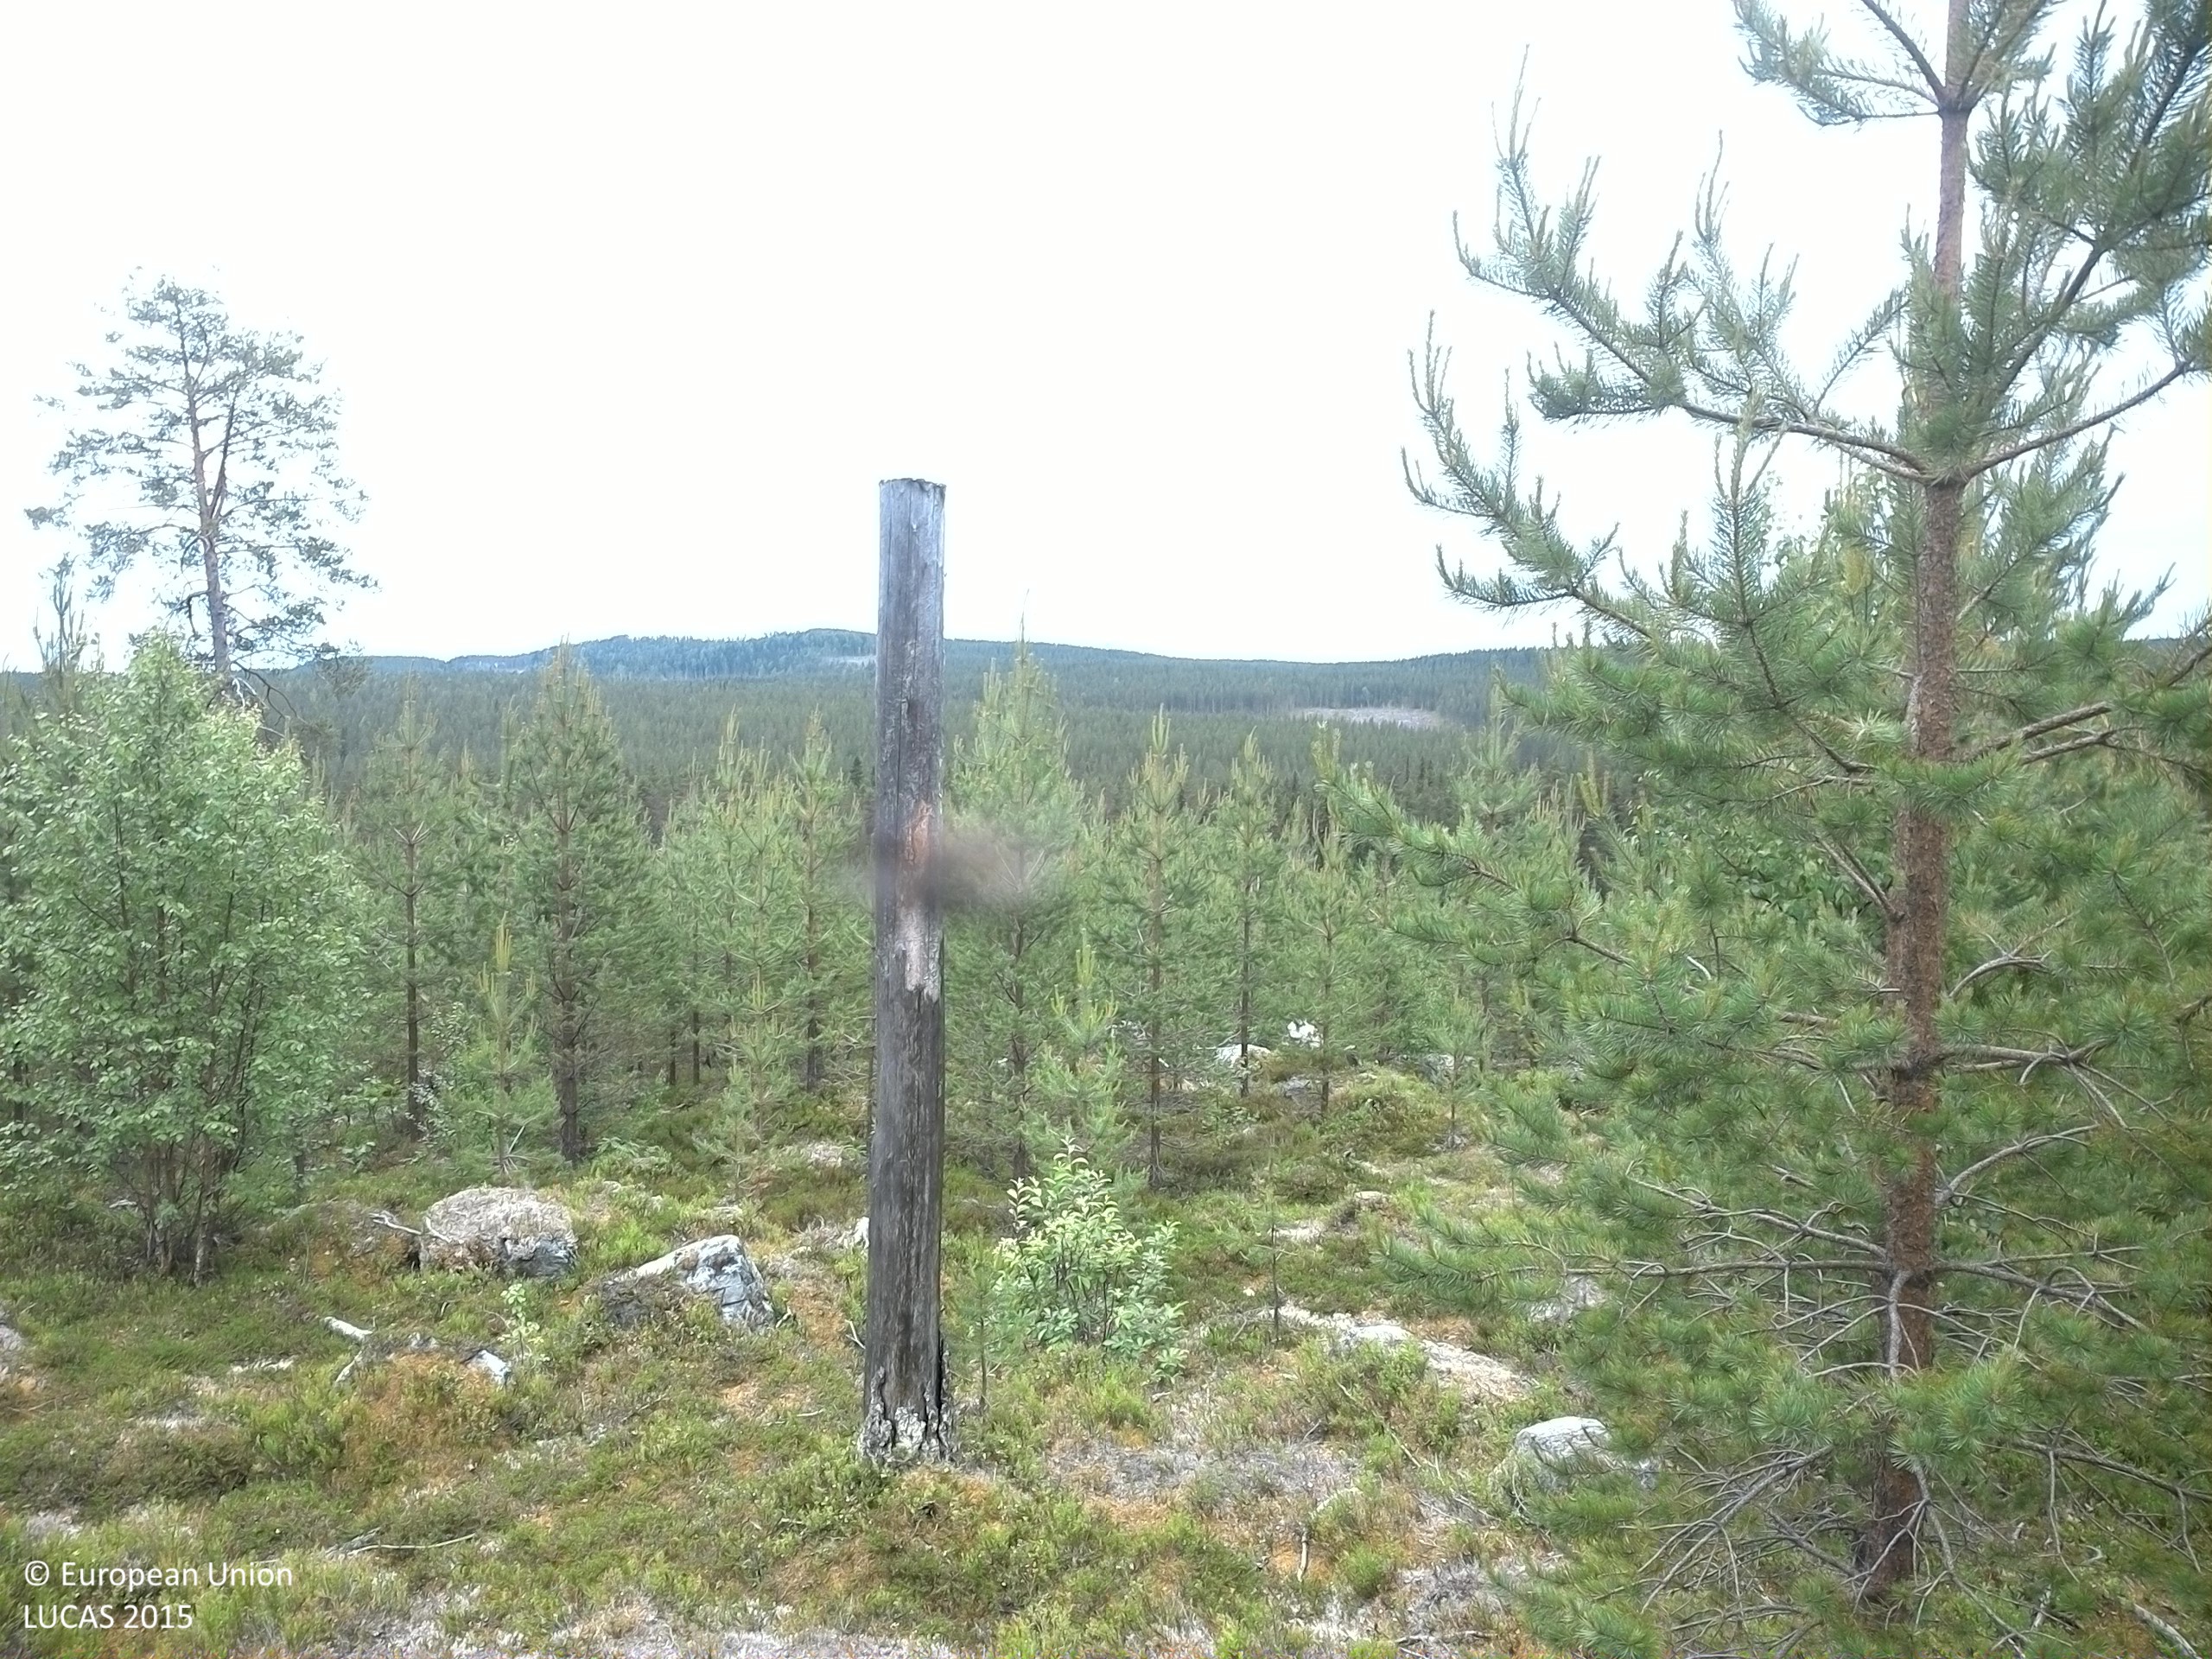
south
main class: Woodland
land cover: Pine dominated coniferous woodland
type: boreal forest
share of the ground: 50 - 75 %
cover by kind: coniferous forest trees 50 %, shrubs 20 %, lichens and mosses 20 %, broadleaved forest trees 10 %
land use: Forestry
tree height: < 5 m
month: July
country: SE
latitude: 63.6063
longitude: 17.8170
